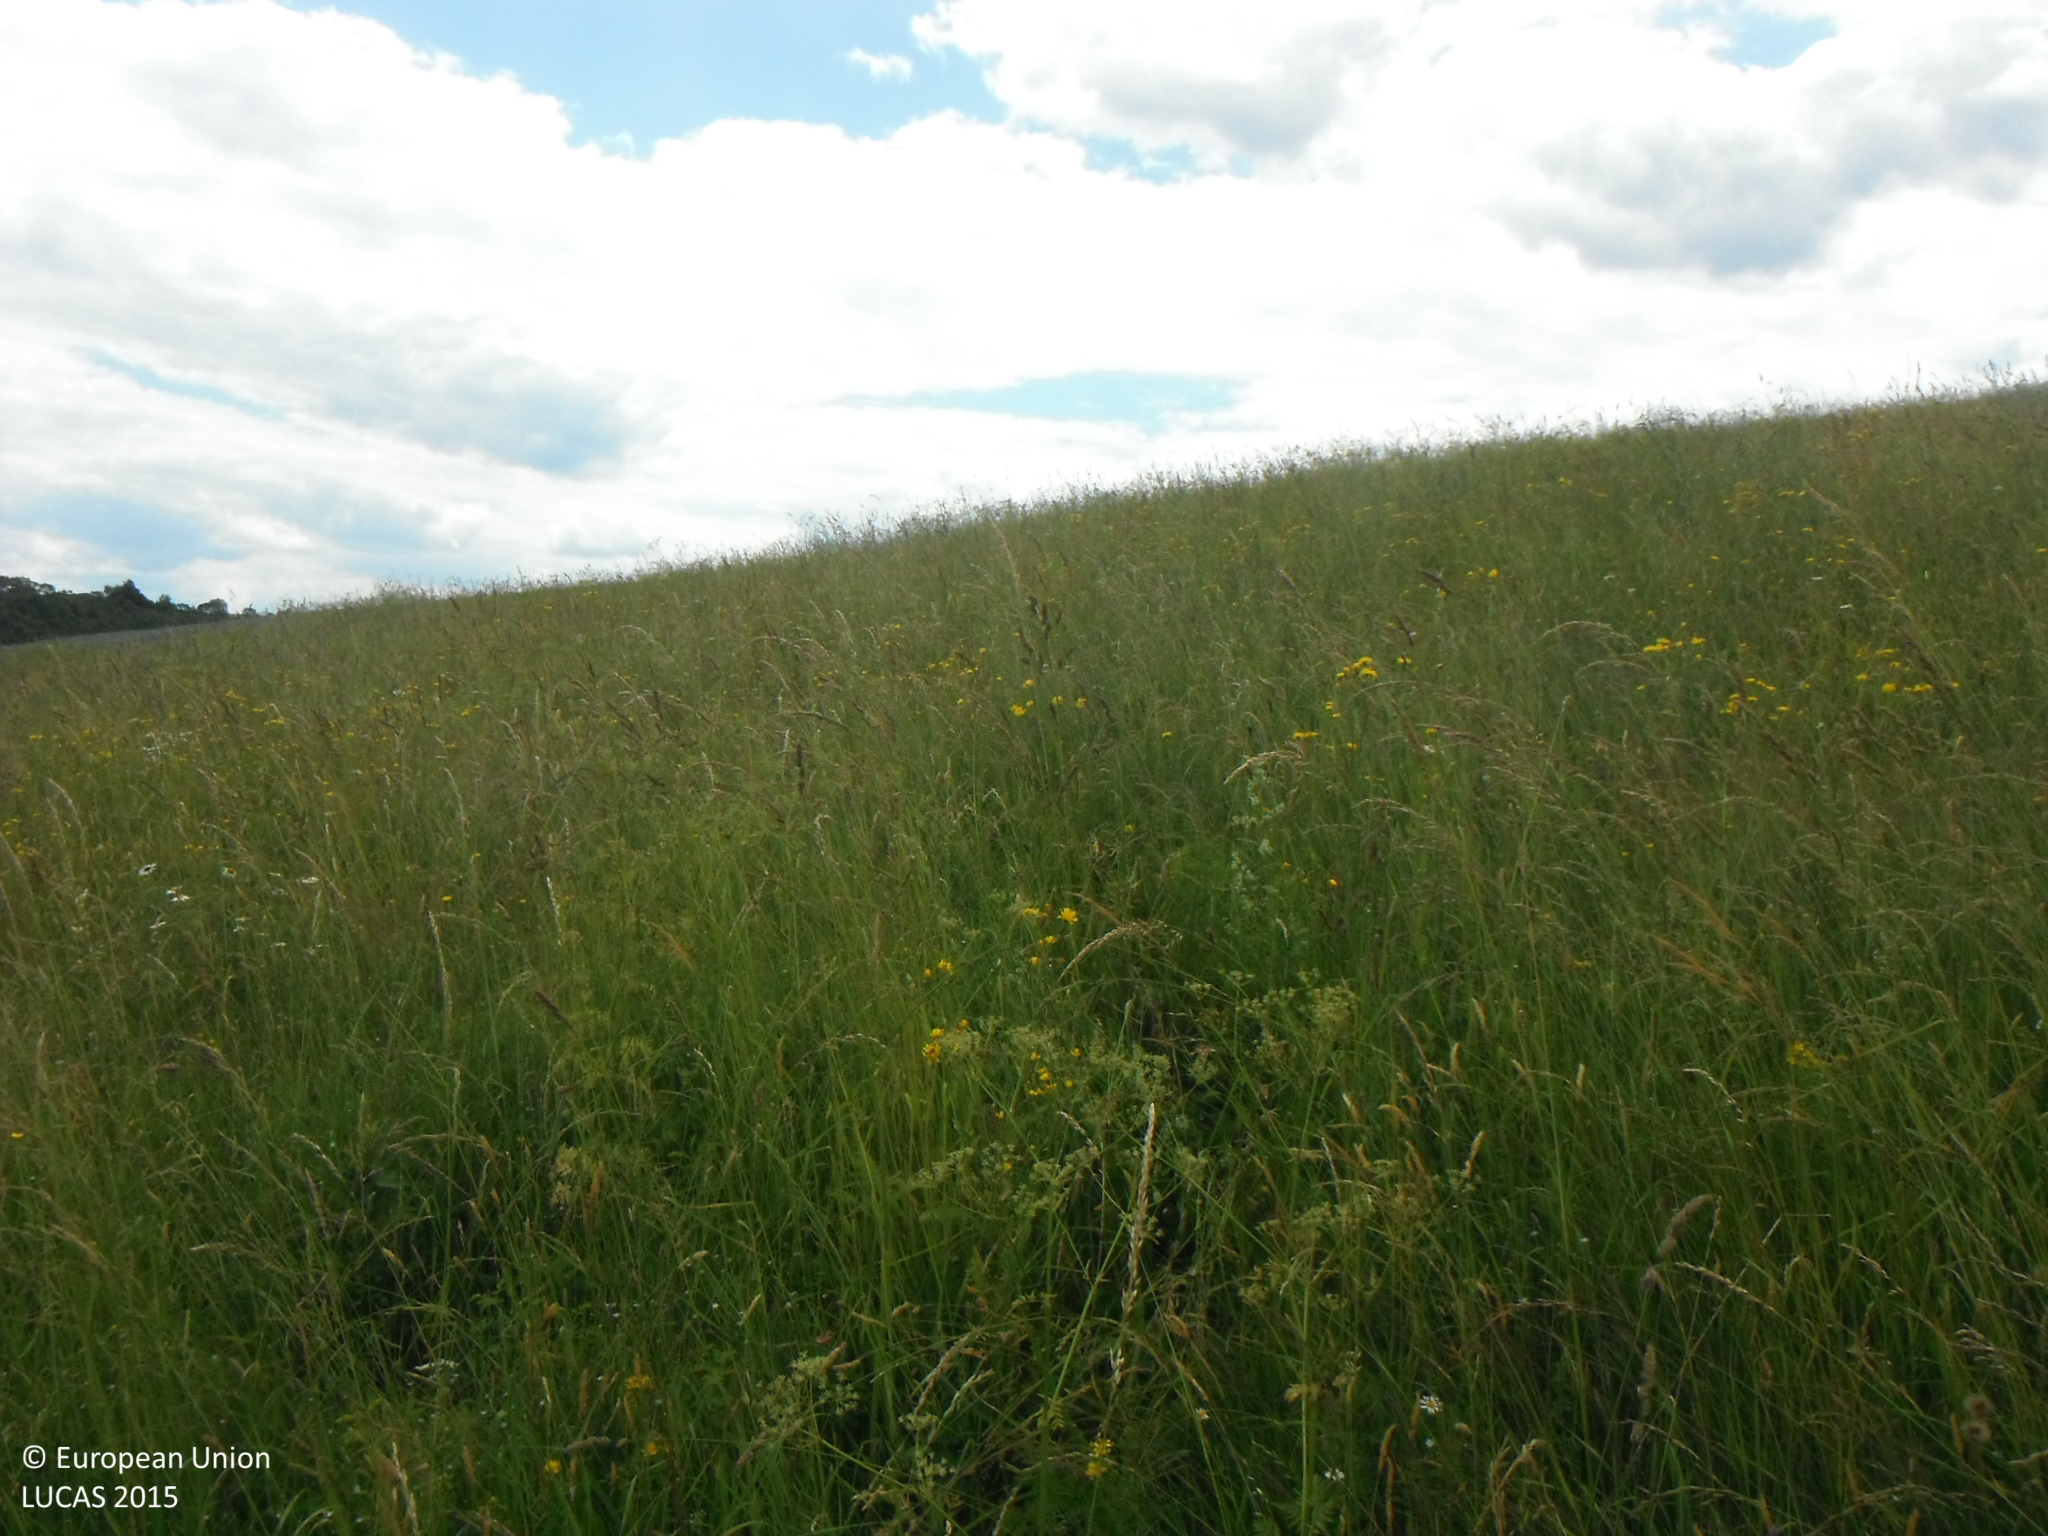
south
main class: Grassland
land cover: Grassland without tree/shrub cover
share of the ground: > 75 %
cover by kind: herbaceous plants 100 %
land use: Agriculture (excluding fallow land and kitchen gardens)
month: June
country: SK
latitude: 48.9442
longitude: 22.3628
